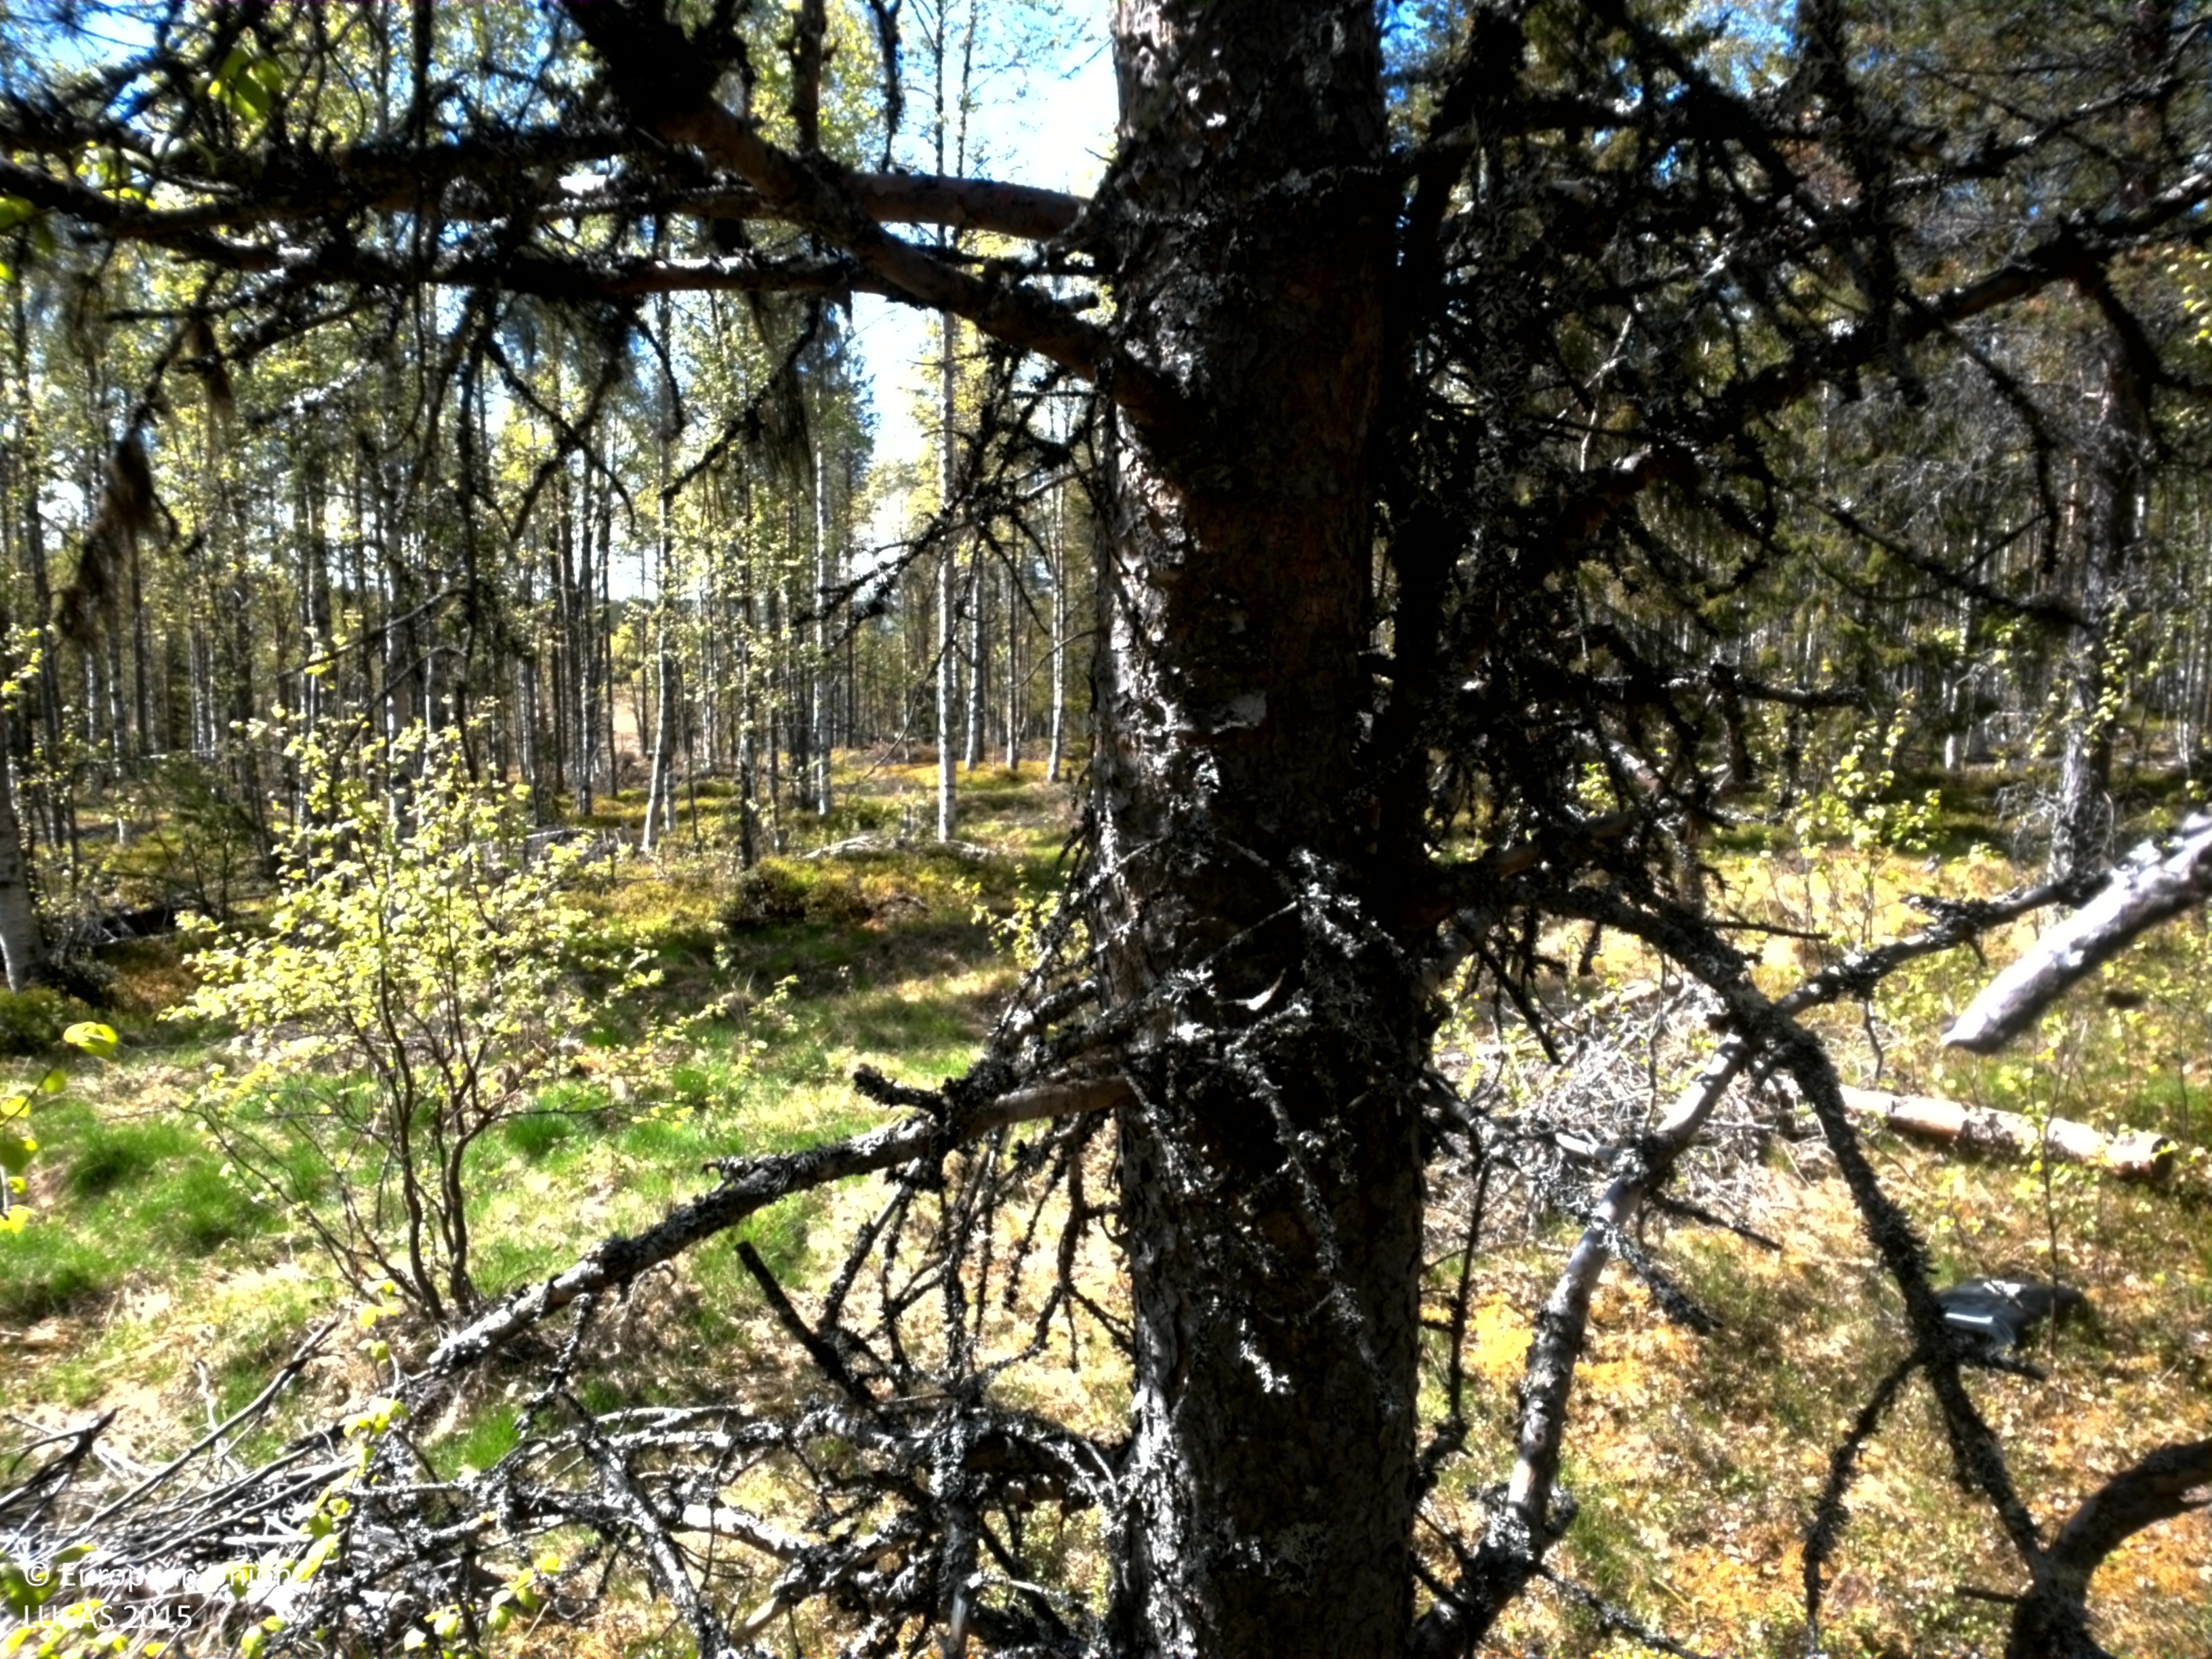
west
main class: Woodland
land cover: Pine dominated mixed woodland
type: boreal forest
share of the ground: 25 - 50 %
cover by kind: coniferous forest trees 30 %, herbaceous plants 30 %, broadleaved forest trees 20 %, shrubs 10 %, lichens and mosses 10 %
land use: Forestry
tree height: > 5 m
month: June
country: SE
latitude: 64.3543
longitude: 17.3611
